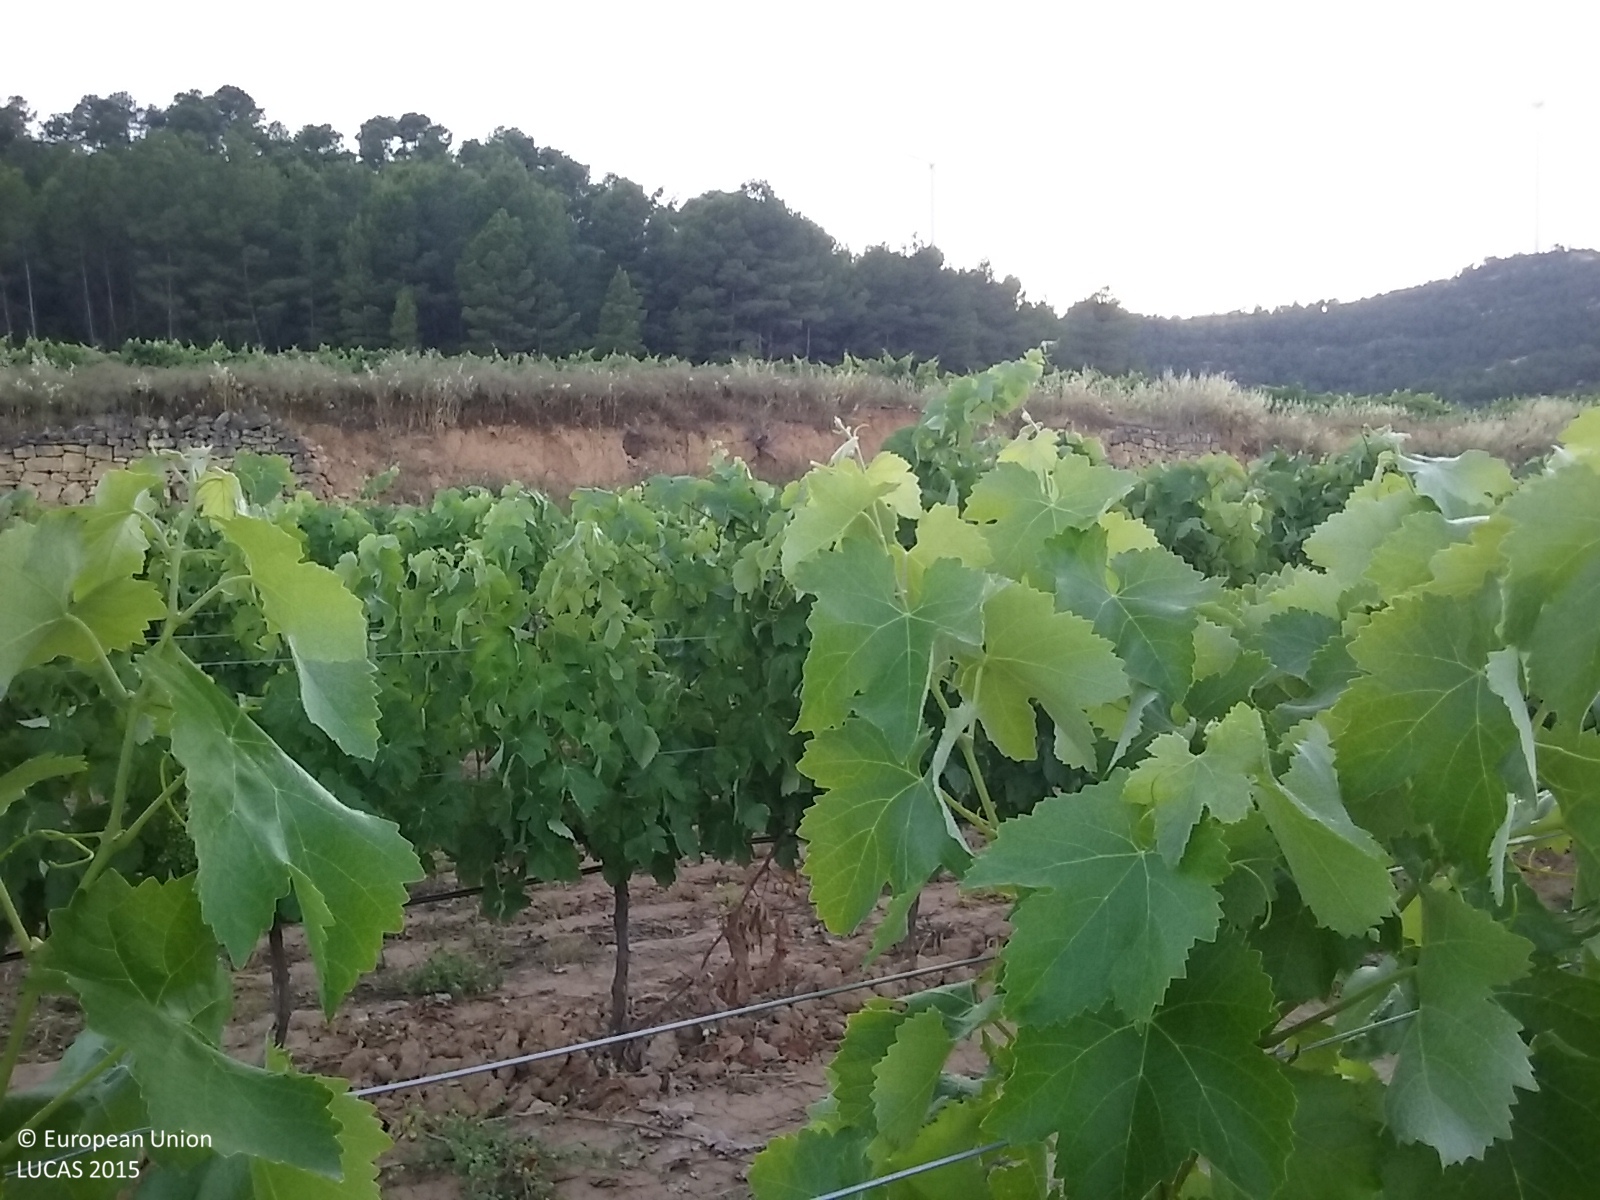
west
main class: Cropland
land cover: Vineyards
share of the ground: 10 - 25 %
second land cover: Spontaneously vegetated surfaces
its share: 10 - 25 %
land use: Agriculture (excluding fallow land and kitchen gardens)
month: June
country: ES
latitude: 41.0100
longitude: 0.3484
